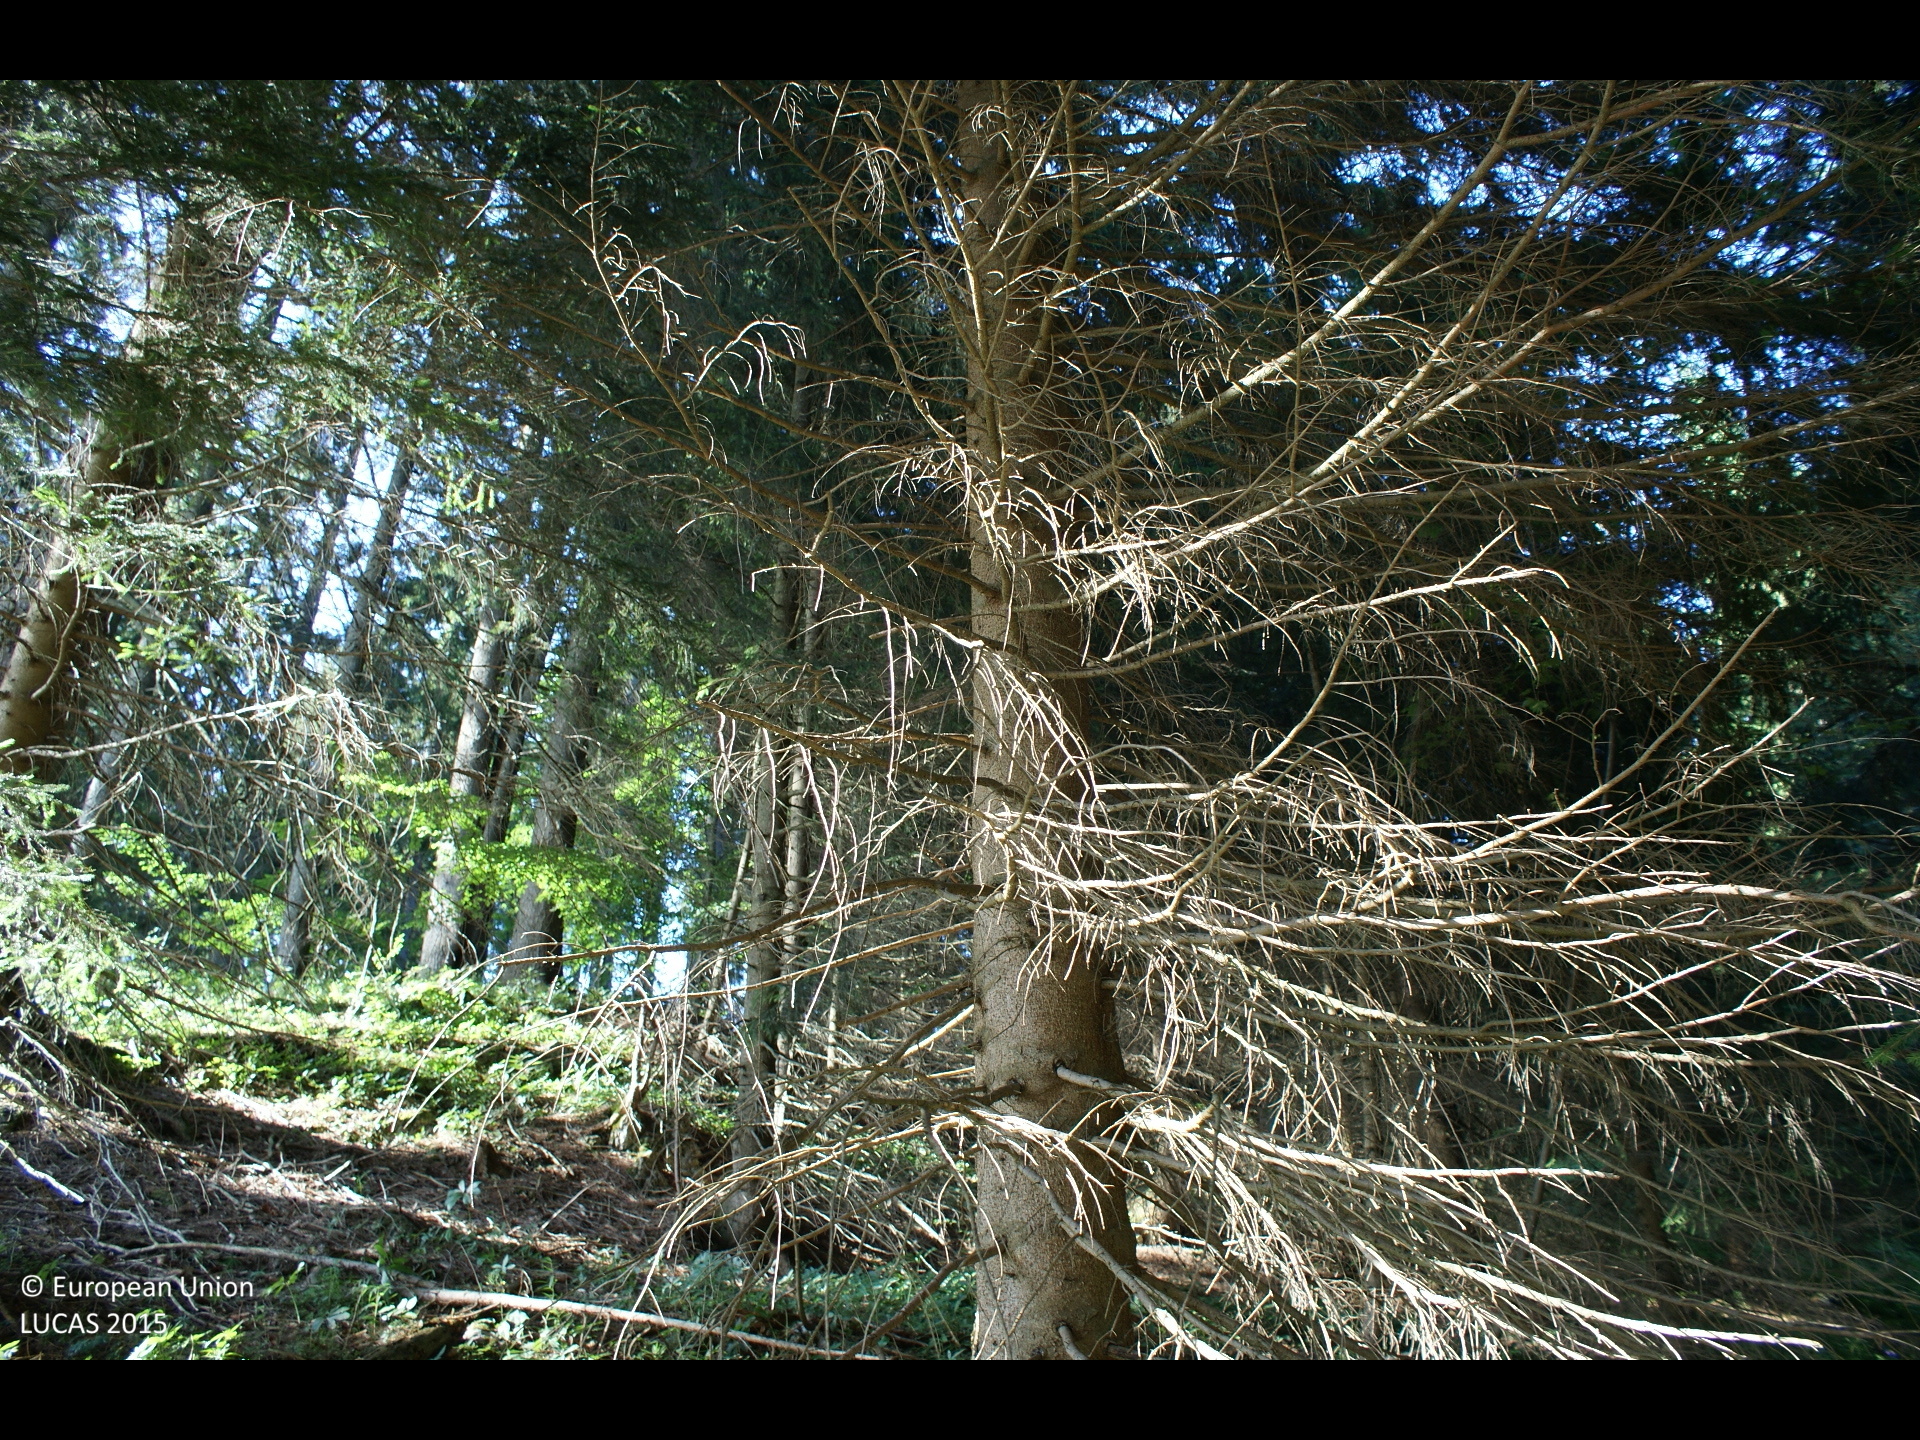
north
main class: Woodland
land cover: Spruce dominated coniferous woodland
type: alpine coniferous forest
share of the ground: > 75 %
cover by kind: coniferous forest trees 80 %, herbaceous plants 20 %
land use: Forestry
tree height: > 5 m
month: July
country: AT
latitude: 47.8984
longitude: 15.2849
